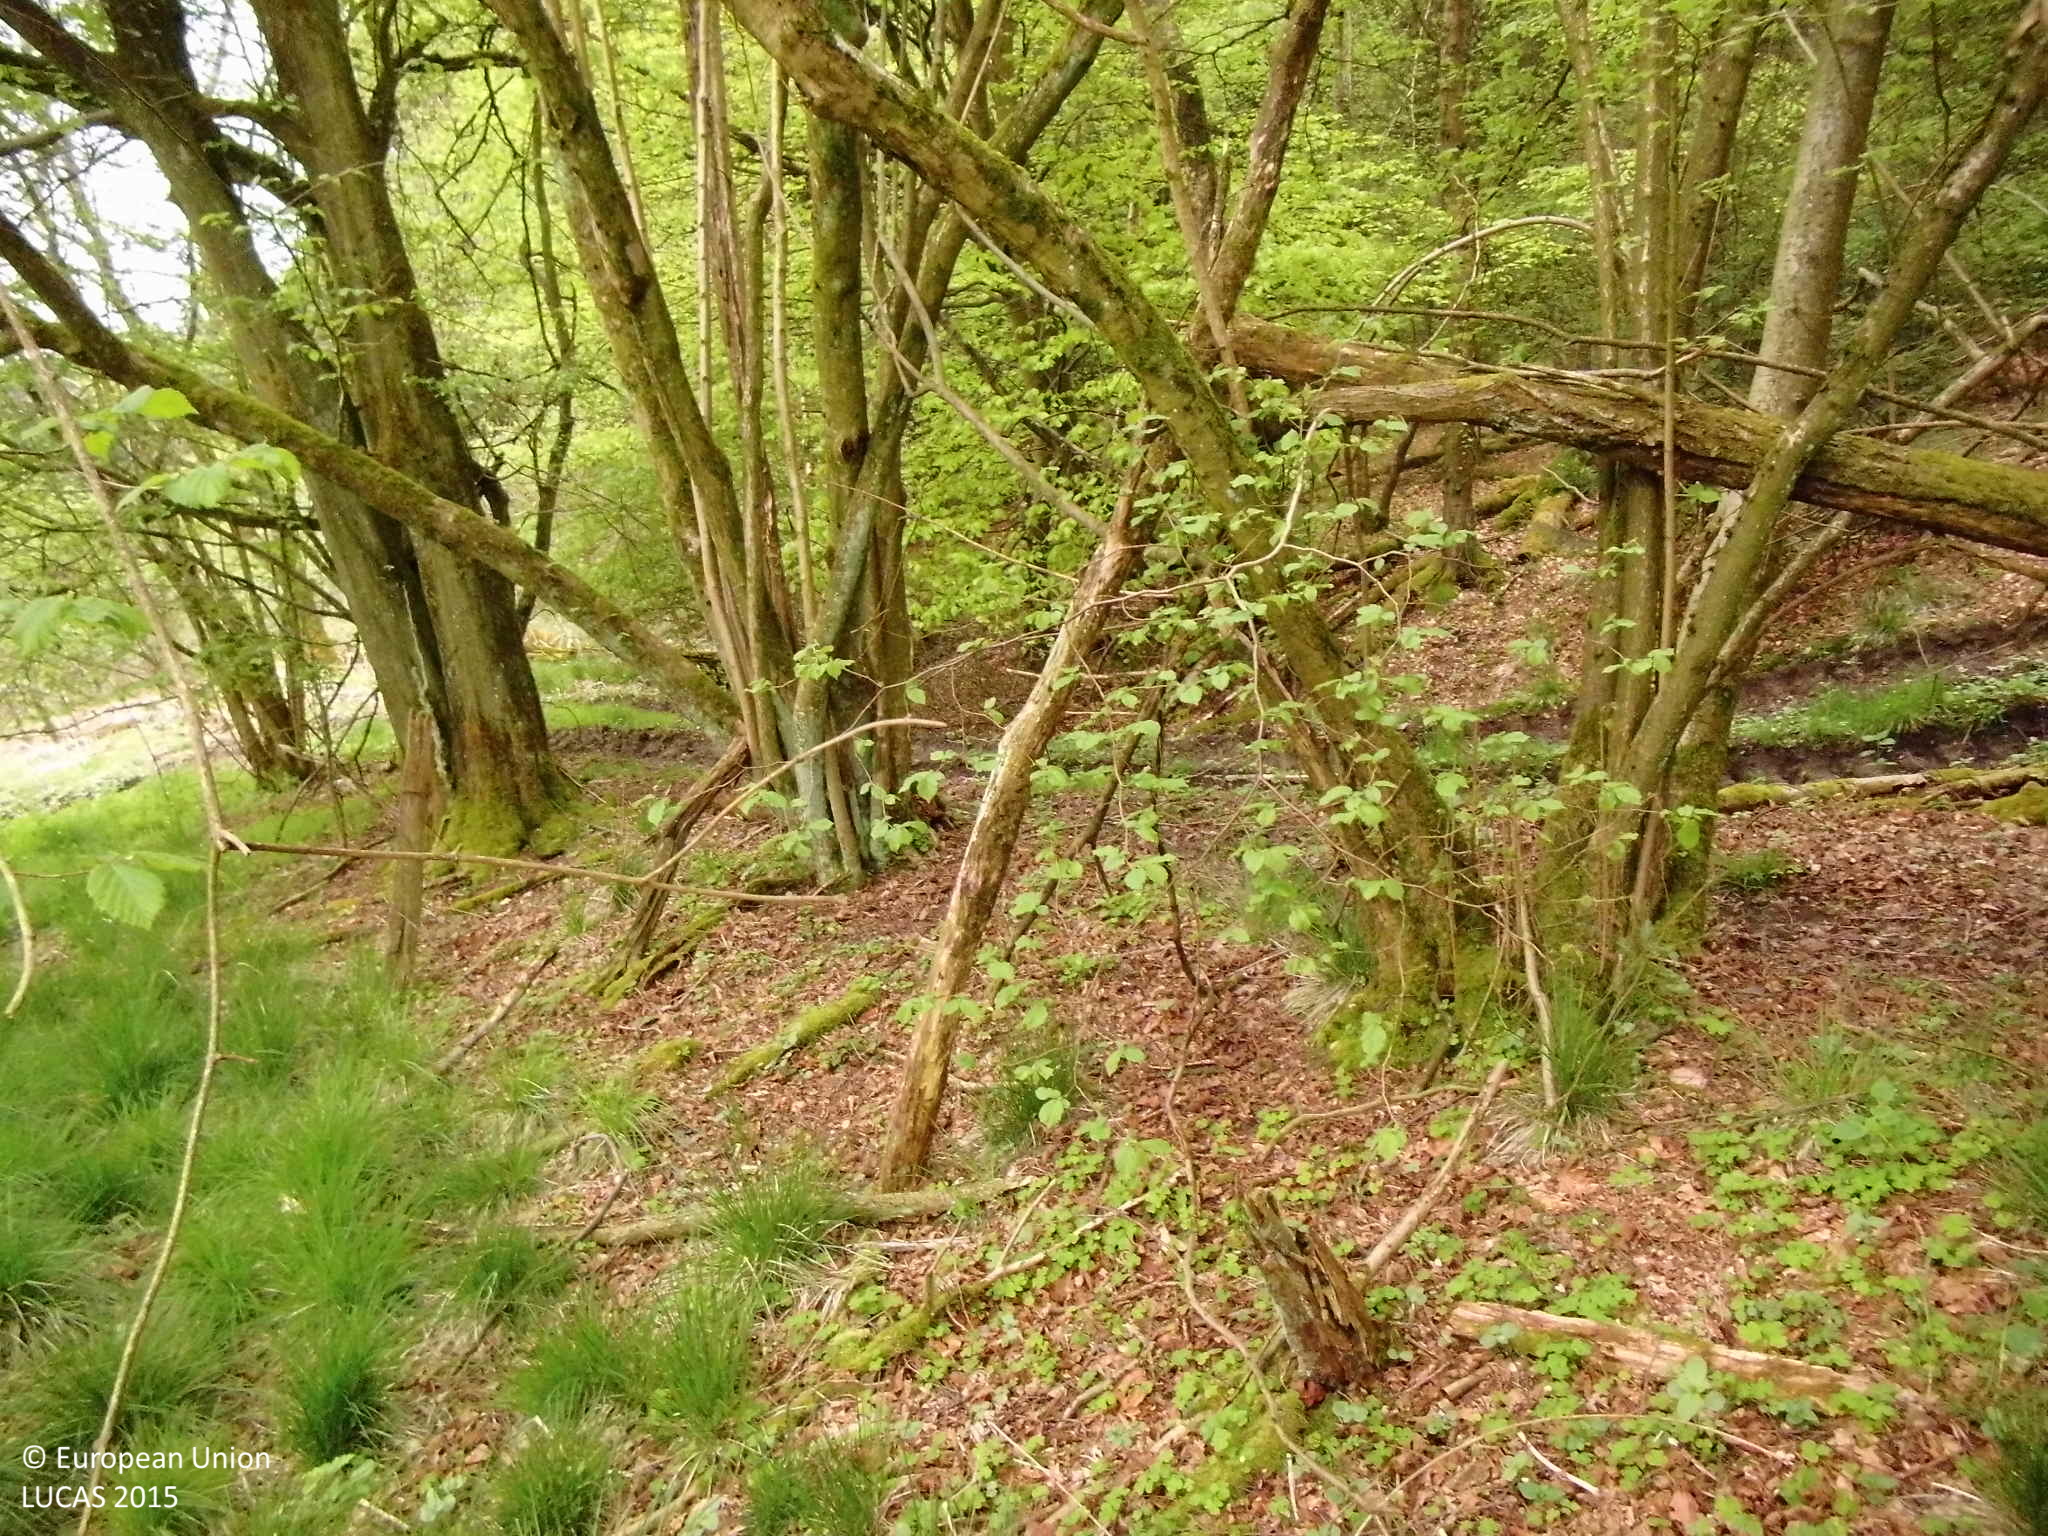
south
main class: Grassland
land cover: Grassland without tree/shrub cover
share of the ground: > 75 %
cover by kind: herbaceous plants 75 %, unconsolidated bare surface 20 %, shrubs 5 %
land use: Agriculture (excluding fallow land and kitchen gardens)
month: May
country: DE
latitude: 51.2540
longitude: 7.4928
